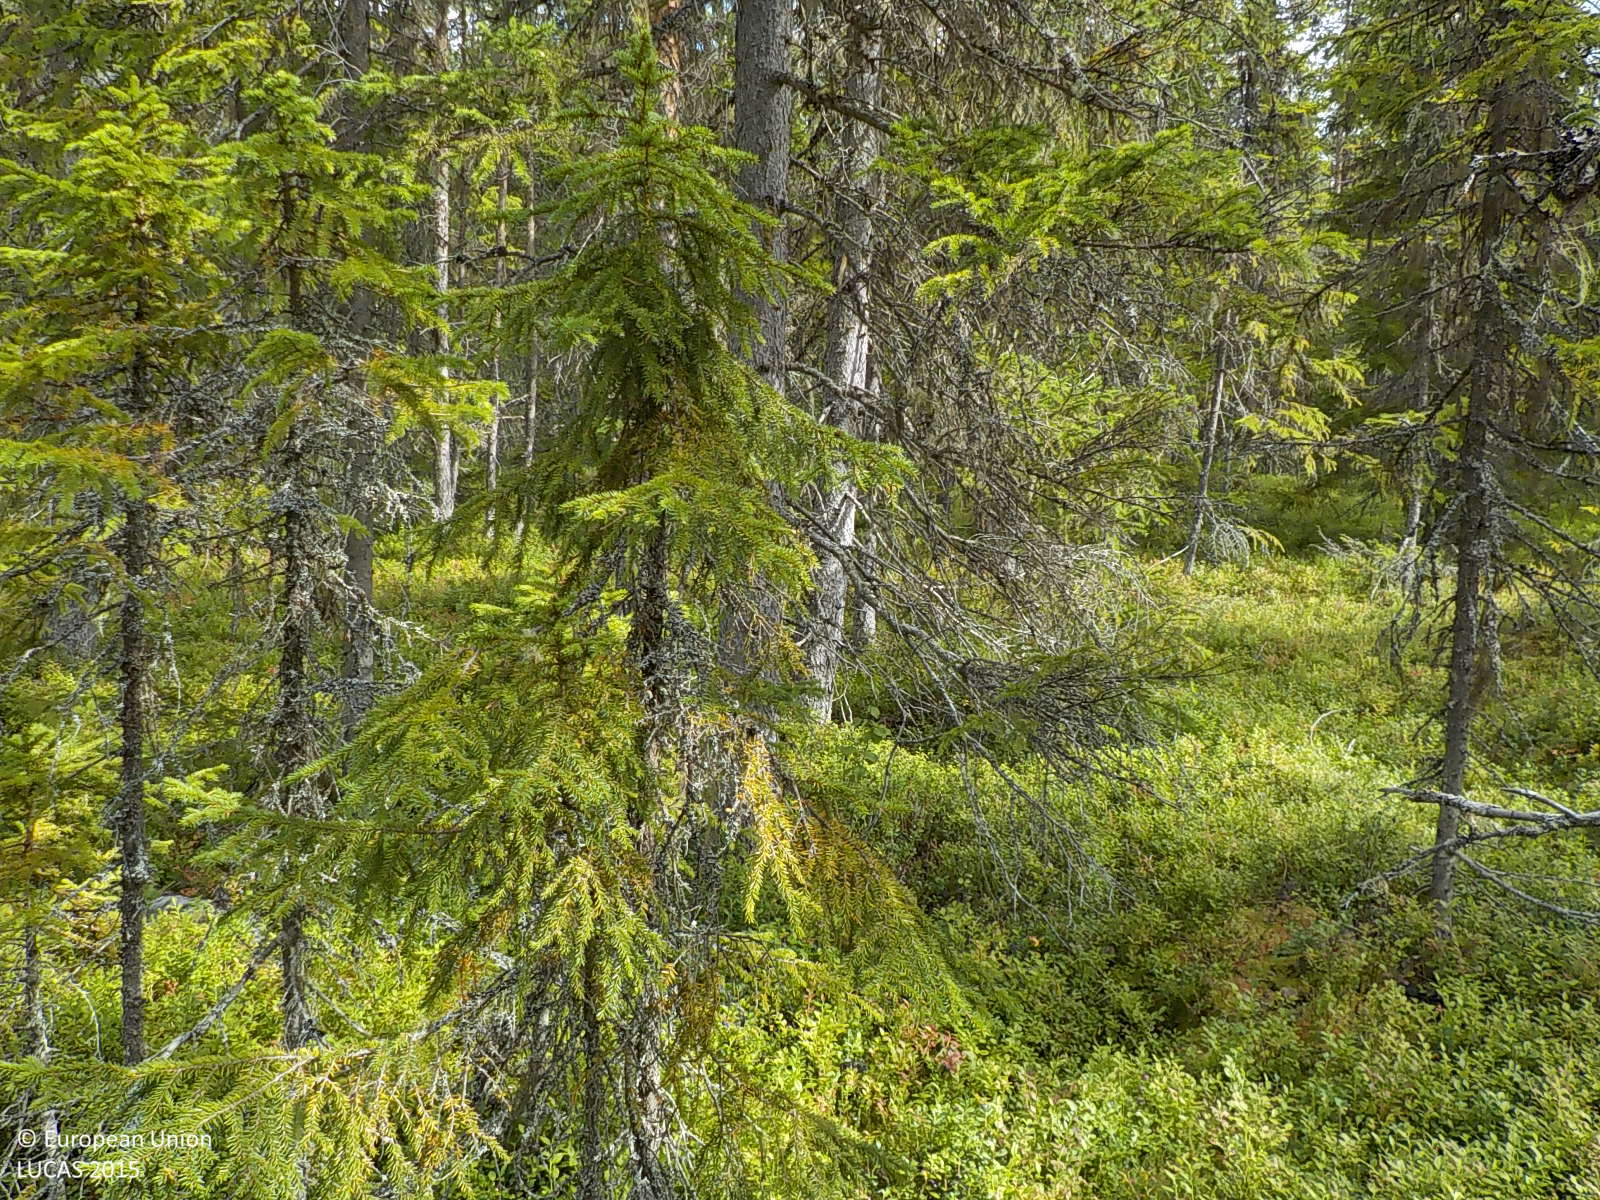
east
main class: Woodland
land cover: Pine dominated coniferous woodland
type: boreal forest
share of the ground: 50 - 75 %
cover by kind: coniferous forest trees 65 %, shrubs 35 %
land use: Forestry
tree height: > 5 m
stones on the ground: 25 - 50 %
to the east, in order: Pine dominated coniferous woodland; Pine dominated mixed woodland
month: September
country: SE
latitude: 63.3788
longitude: 17.2757
